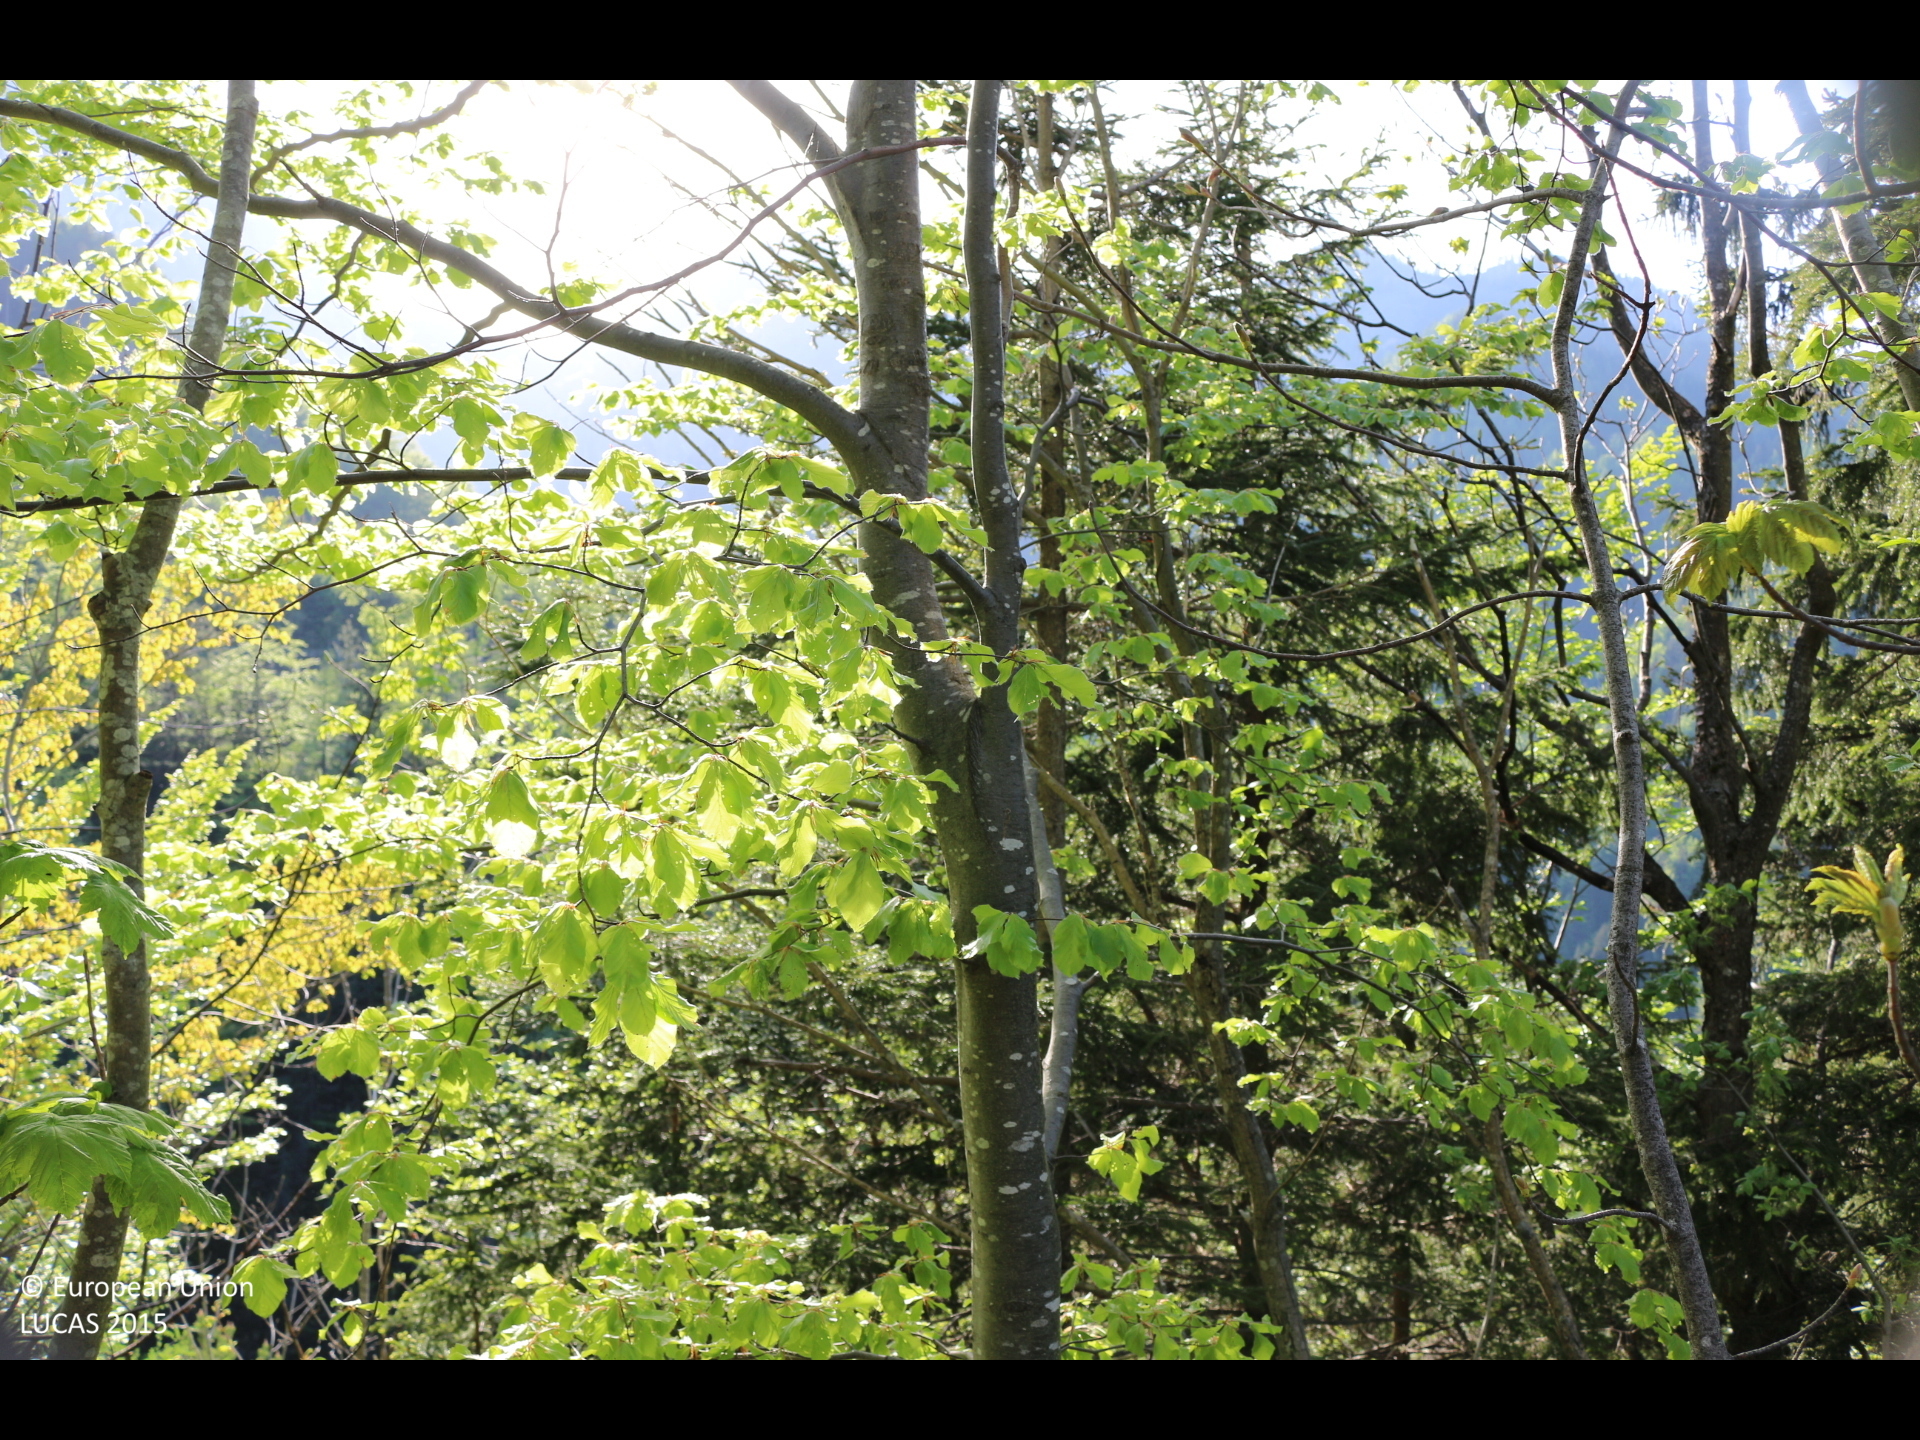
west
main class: Woodland
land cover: Spruce dominated mixed woodland
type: alpine coniferous forest
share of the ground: > 75 %
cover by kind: coniferous forest trees 60 %, broadleaved forest trees 40 %
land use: Forestry
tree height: > 5 m
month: May
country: AT
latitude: 46.4470
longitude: 14.2539
